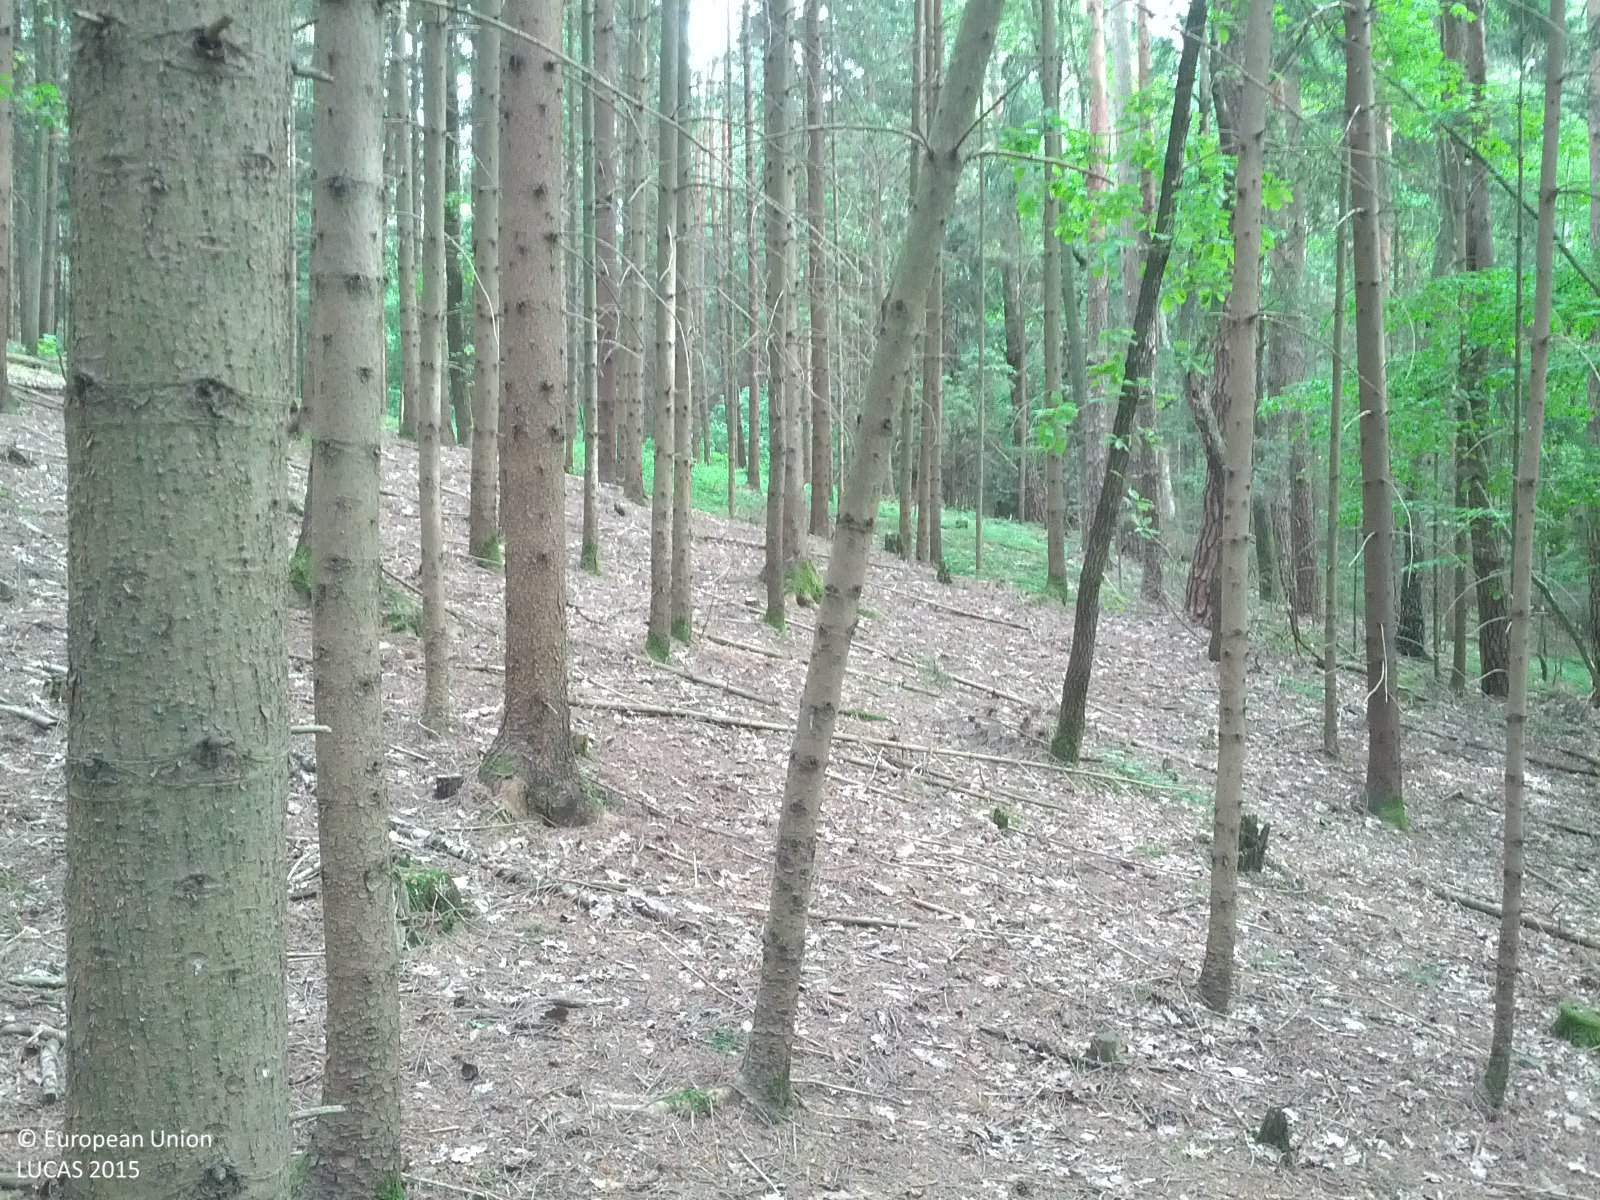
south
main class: Woodland
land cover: Spruce dominated coniferous woodland
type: hemiboreal forest and nemoral coniferous forest and mixed broadleaved-coniferous forest
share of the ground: > 75 %
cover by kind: coniferous forest trees 90 %, broadleaved forest trees 5 %, herbaceous plants 5 %
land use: Forestry
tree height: > 5 m
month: May
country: AT
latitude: 47.3699
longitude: 16.0805
